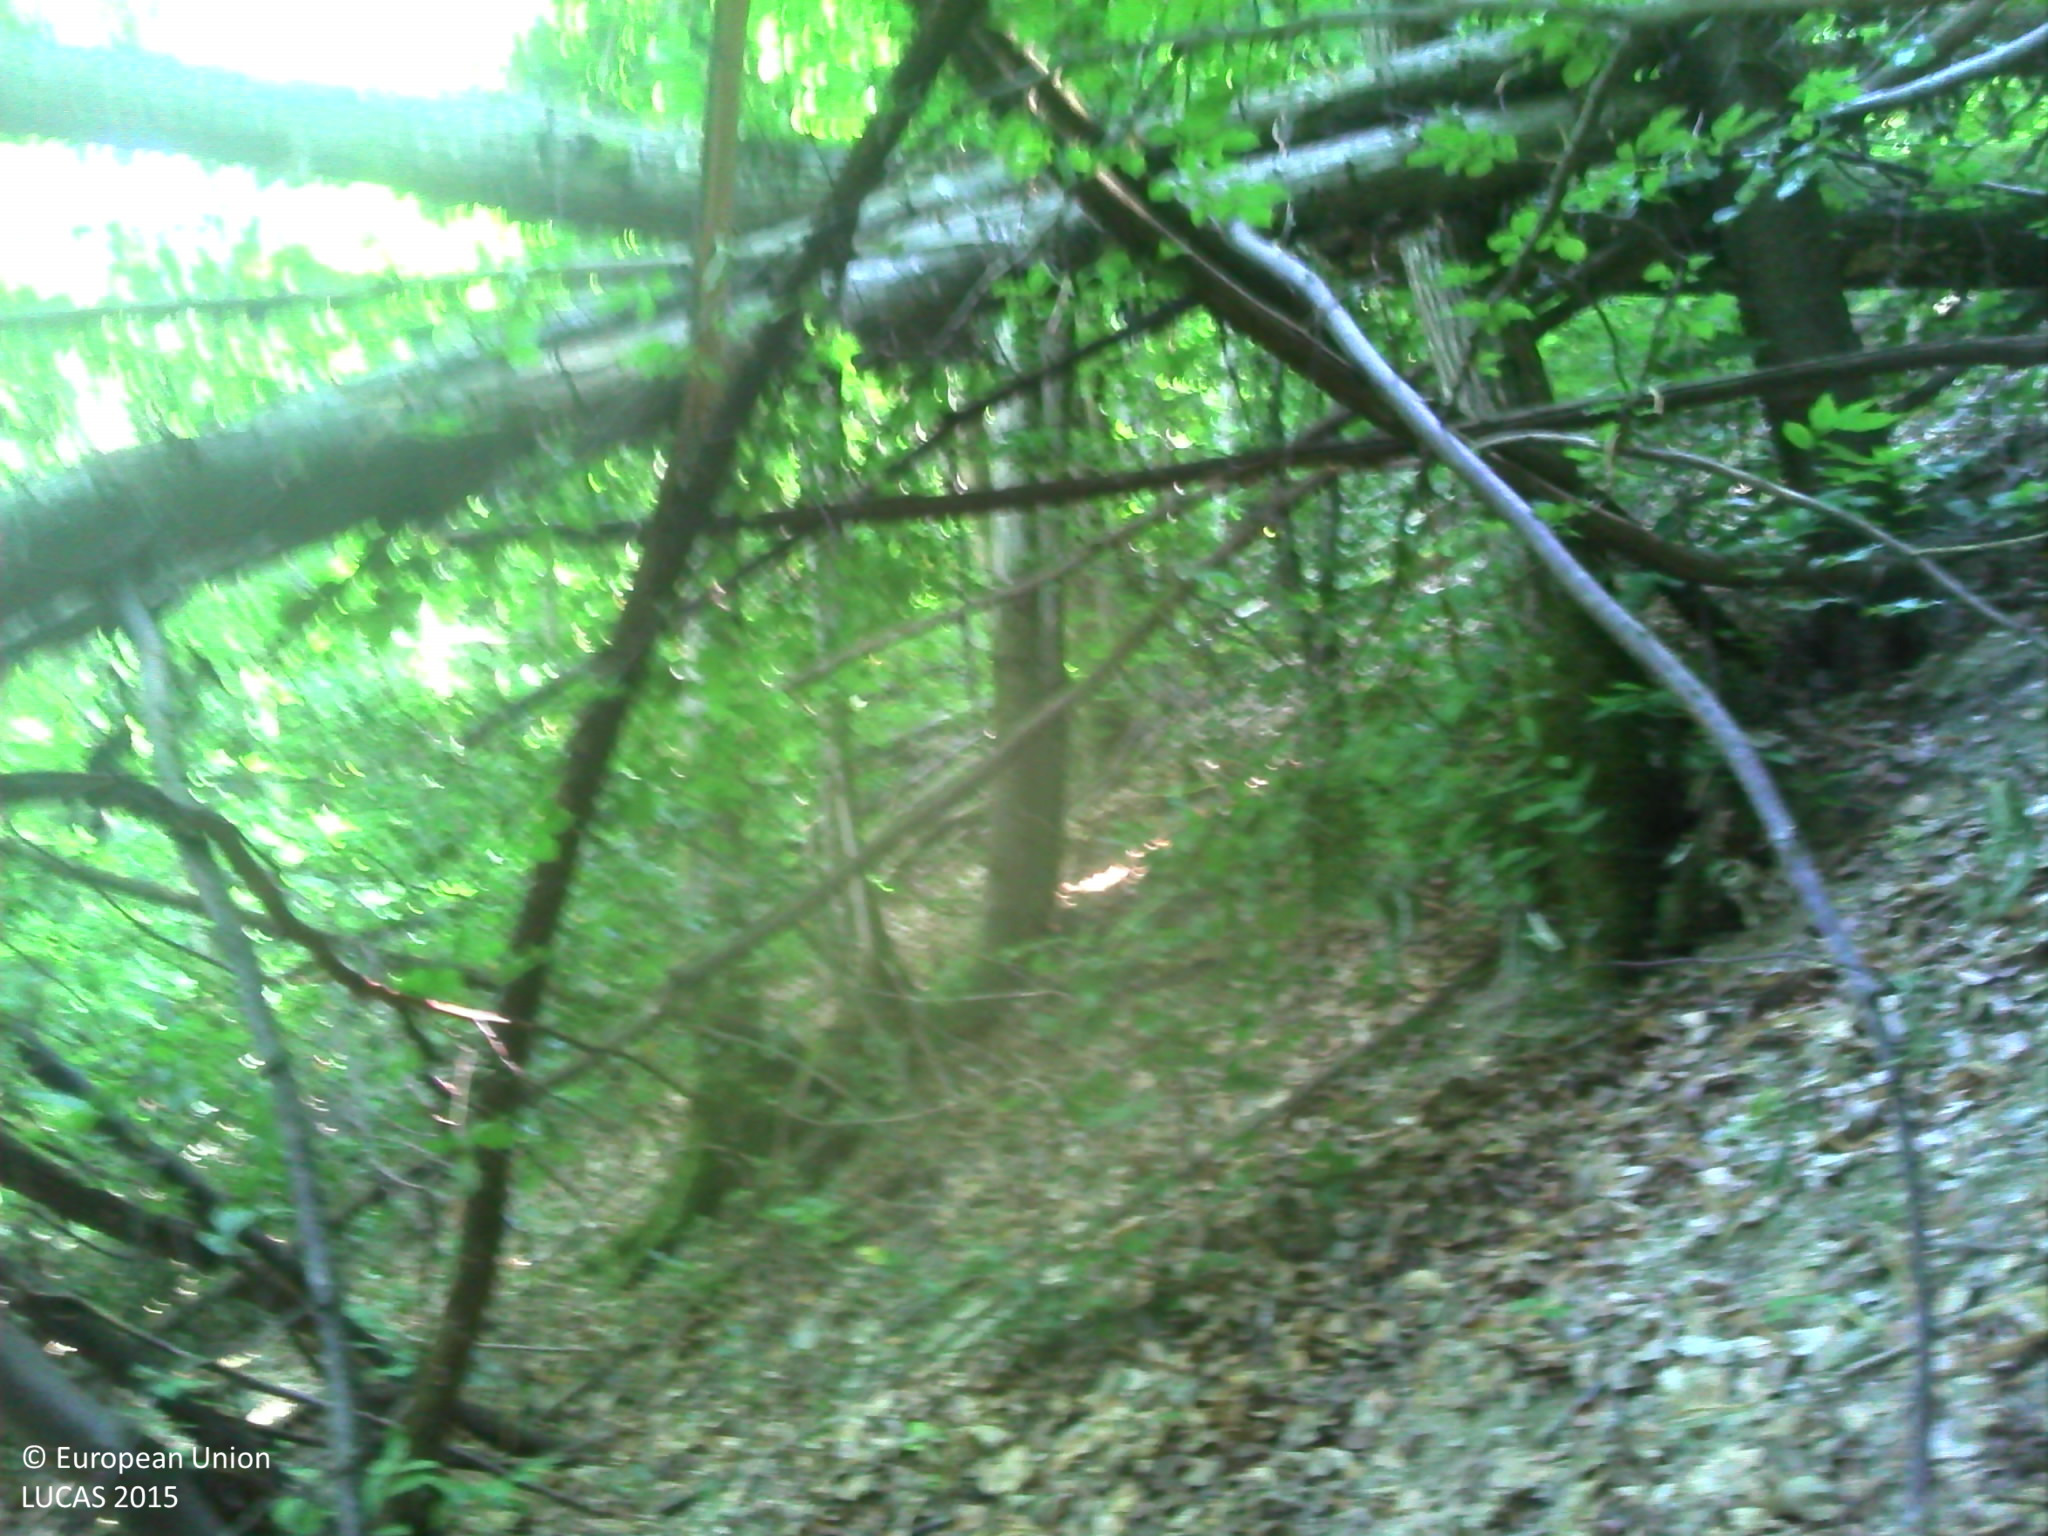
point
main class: Woodland
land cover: Broadleaved woodland
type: mountainous beech forest
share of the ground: > 75 %
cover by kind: broadleaved forest trees 100 %
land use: Forestry
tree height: > 5 m
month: July
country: FR
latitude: 45.6594
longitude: 6.3980
